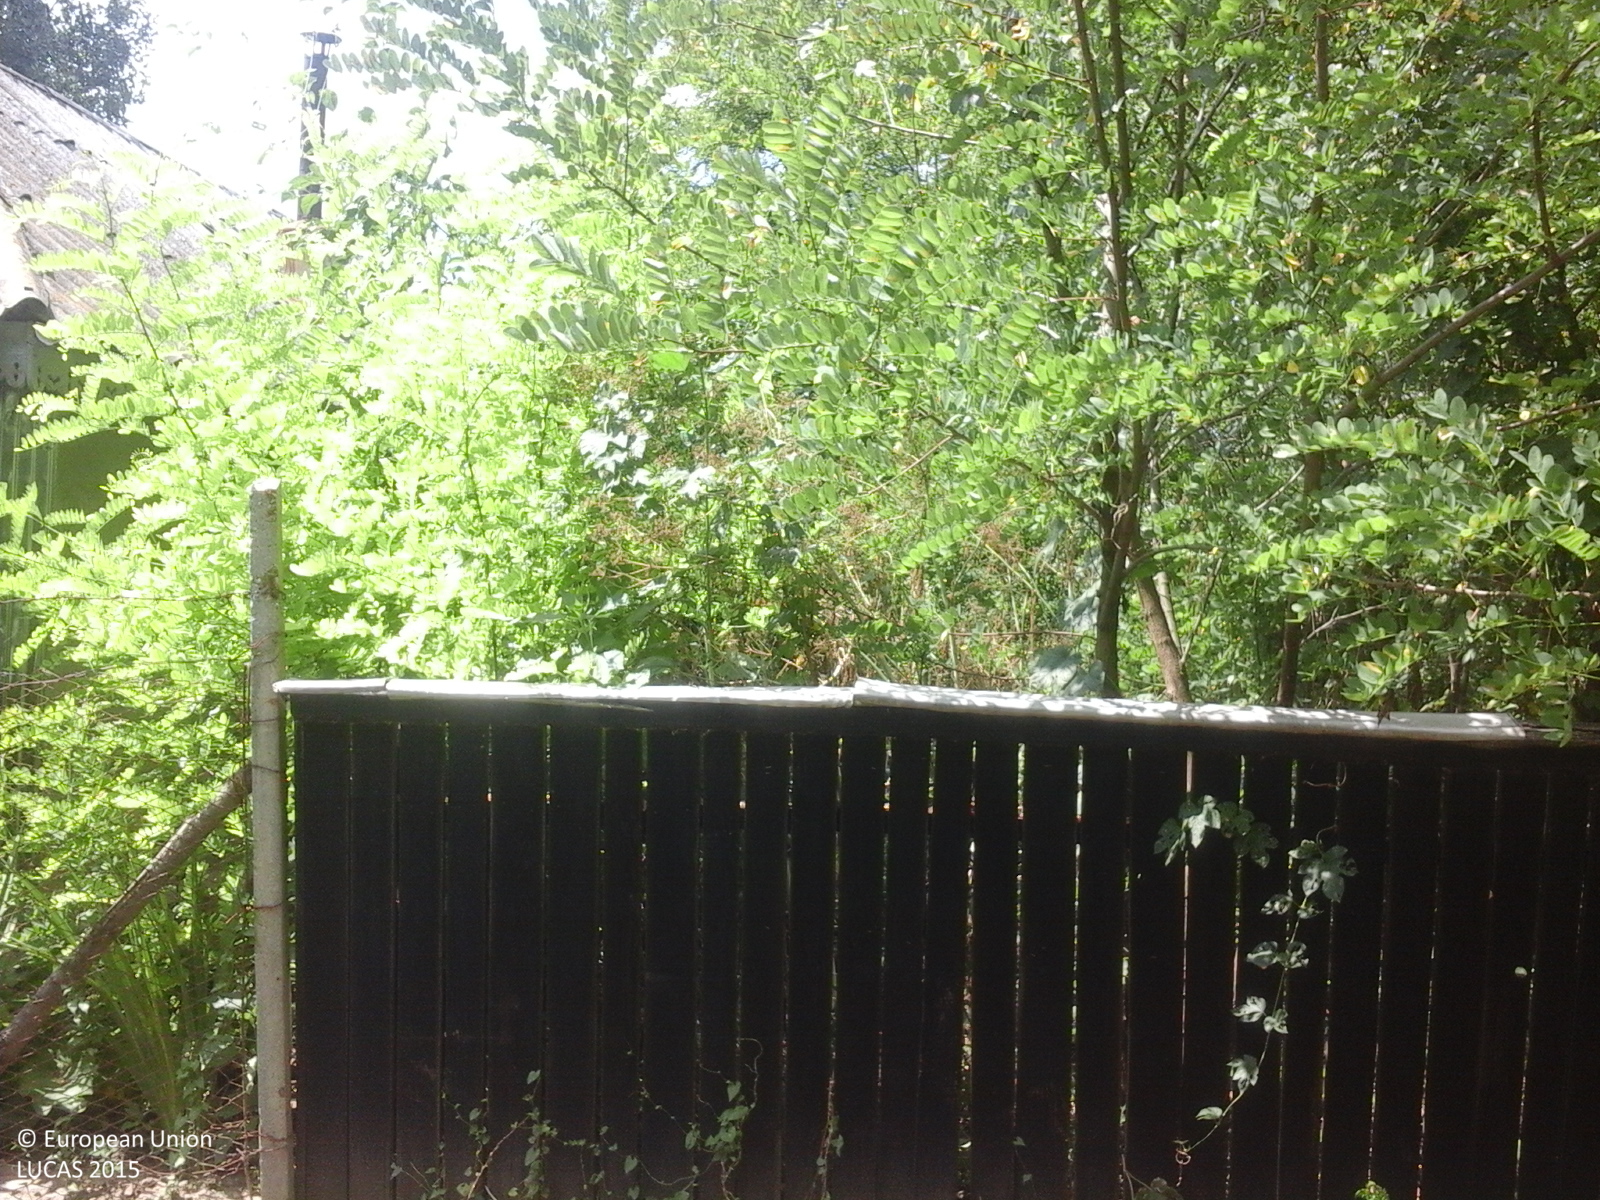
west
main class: Woodland
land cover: Broadleaved woodland
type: exotic forest
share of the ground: > 75 %
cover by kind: broadleaved forest trees 100 %
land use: Agriculture (excluding fallow land and kitchen gardens)
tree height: > 5 m
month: July
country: RO
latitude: 46.4834
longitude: 28.2273
